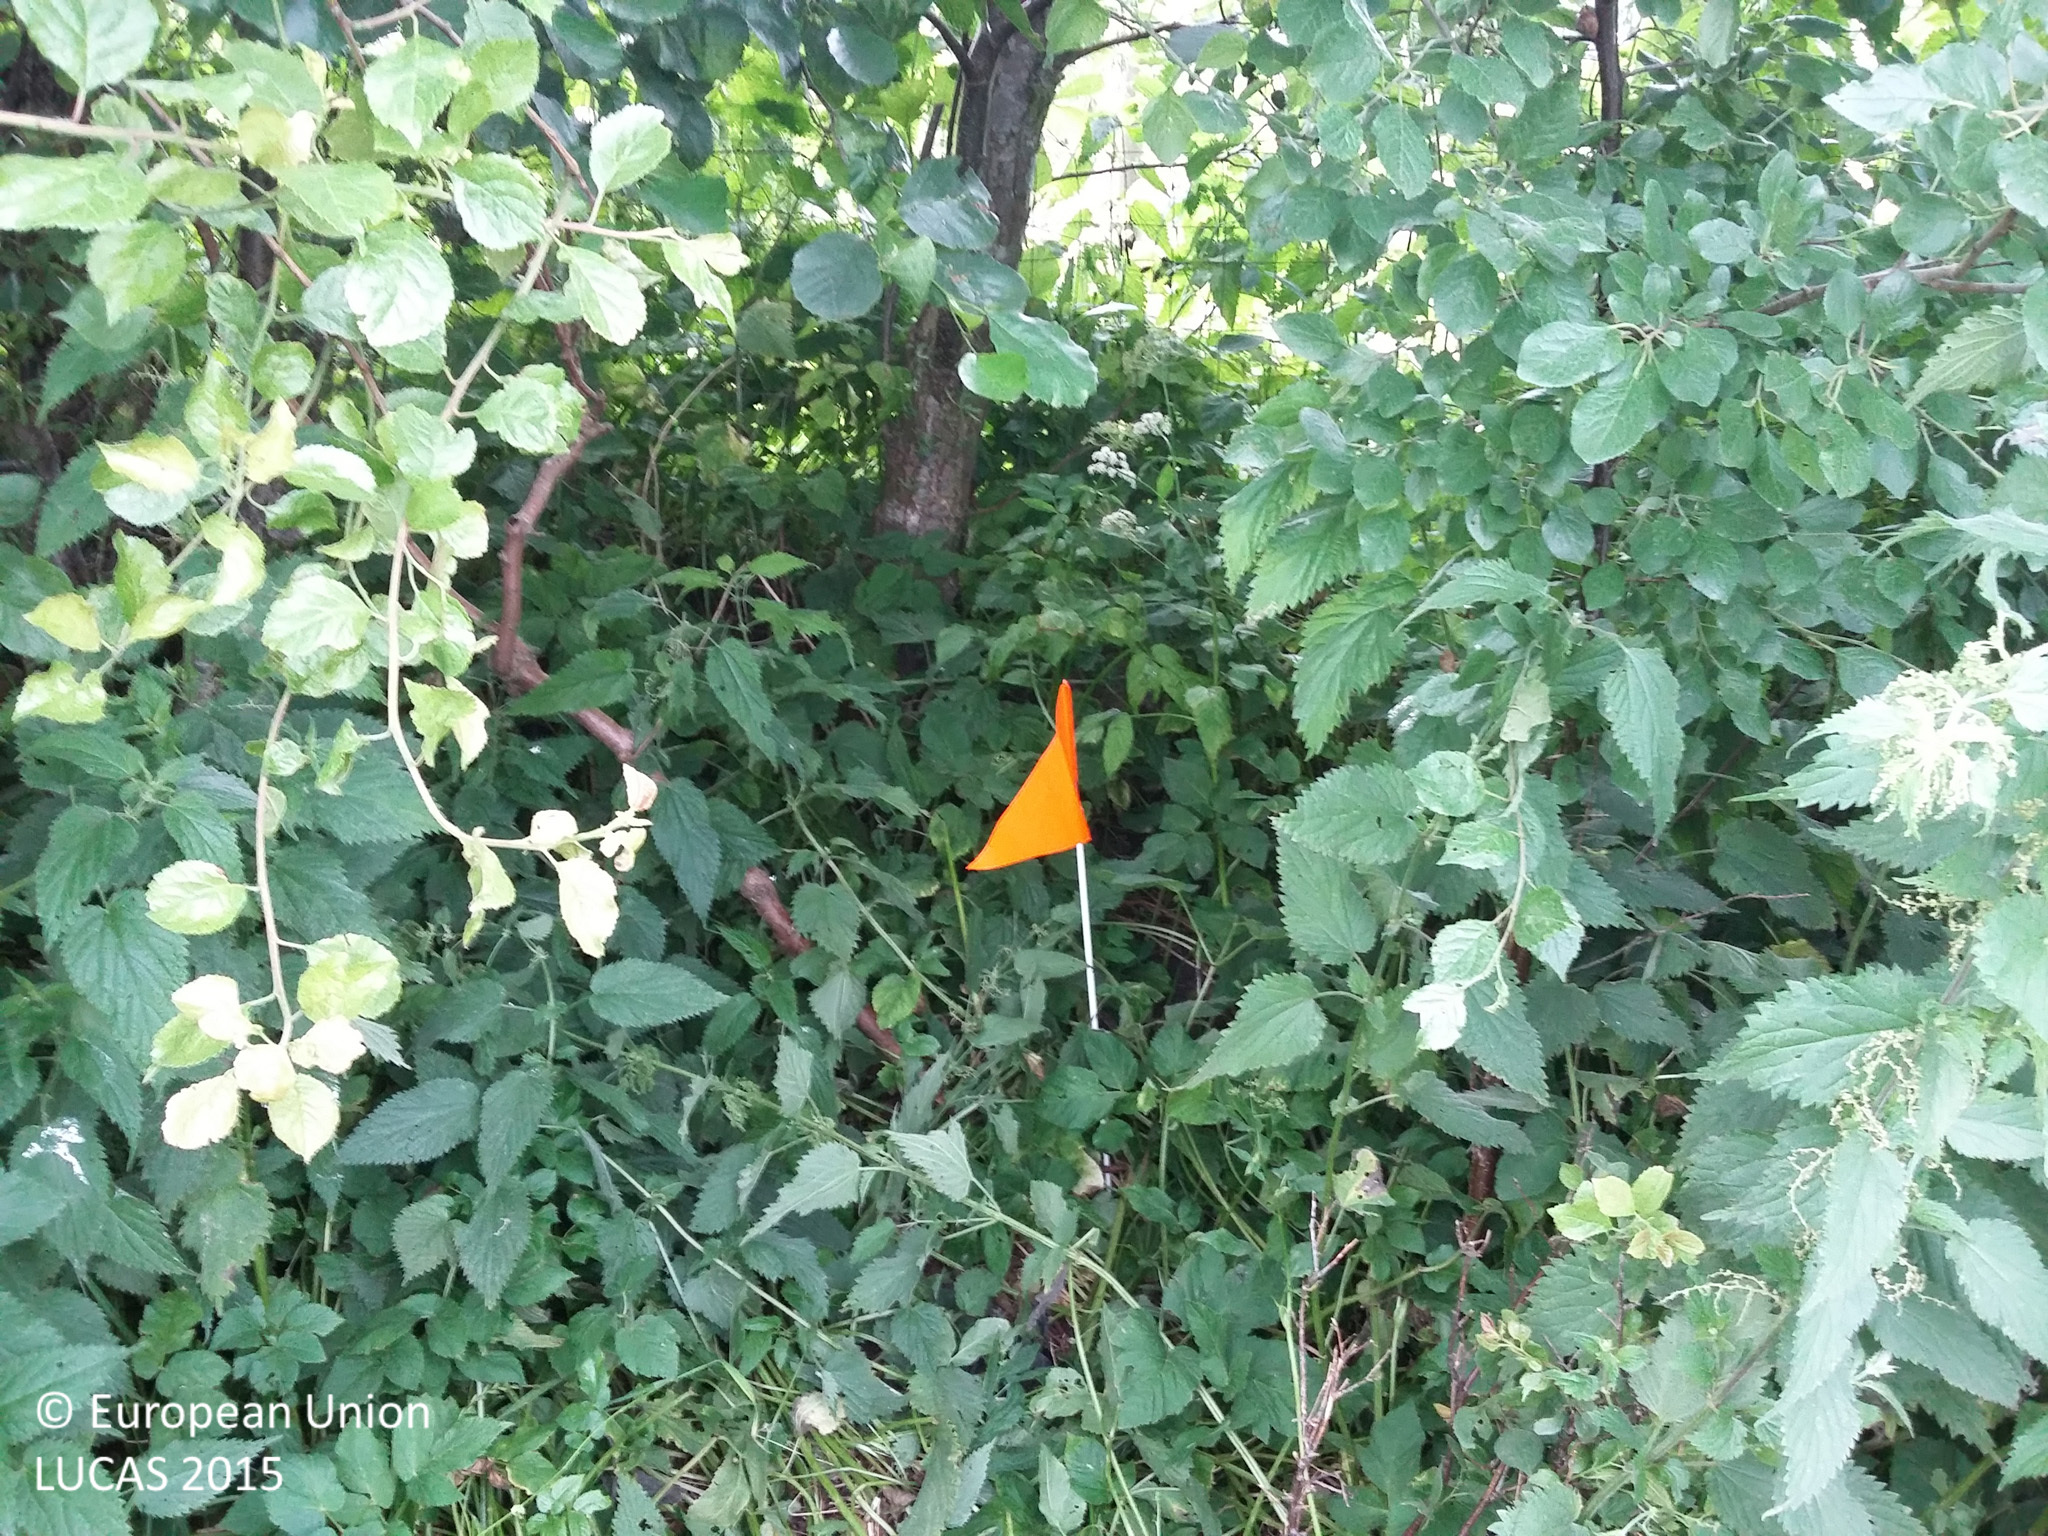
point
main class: Woodland
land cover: Broadleaved woodland
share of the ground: > 75 %
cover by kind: broadleaved forest trees 90 %, herbaceous plants 10 %
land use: Forestry
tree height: > 5 m
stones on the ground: < 10 %
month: July
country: DK
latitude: 55.5691
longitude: 11.3784
